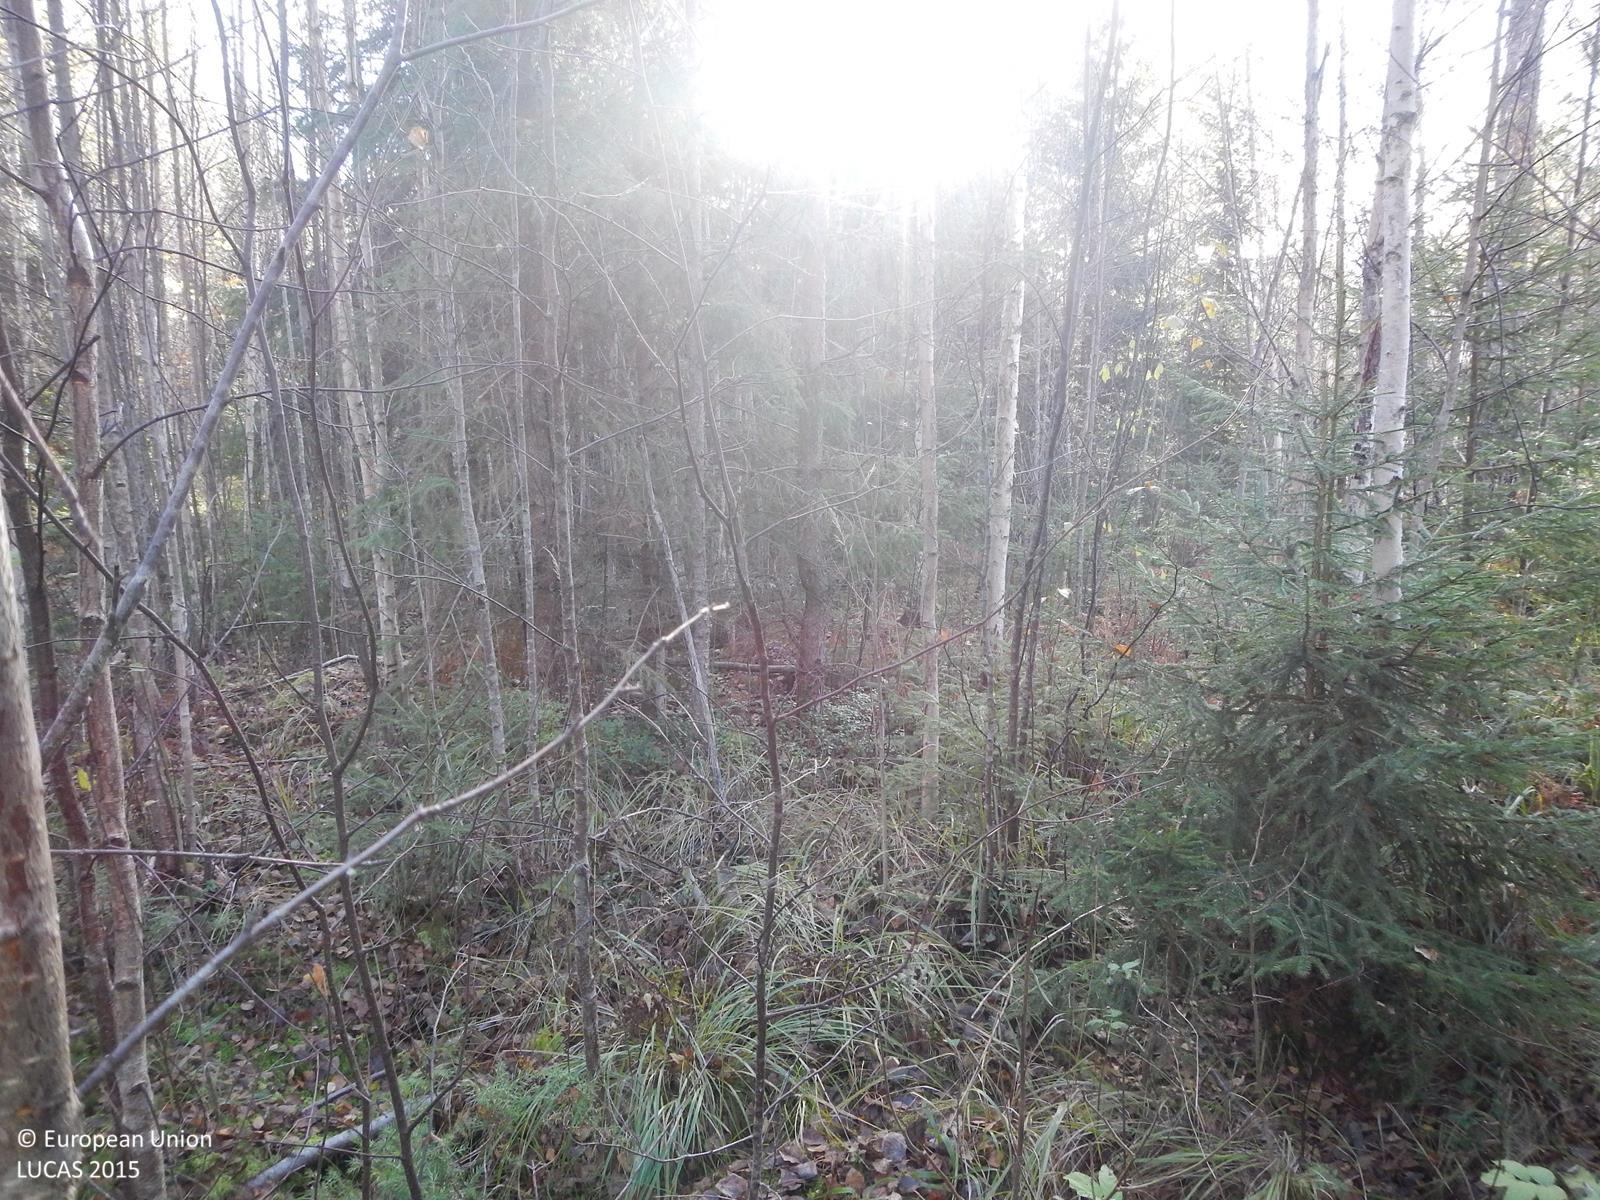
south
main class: Woodland
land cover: Spruce dominated mixed woodland
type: boreal forest
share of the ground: > 75 %
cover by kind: broadleaved forest trees 60 %, coniferous forest trees 30 %, shrubs 5 %, herbaceous plants 5 %
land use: Forestry
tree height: > 5 m
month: October
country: FI
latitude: 61.6357
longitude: 25.8464
